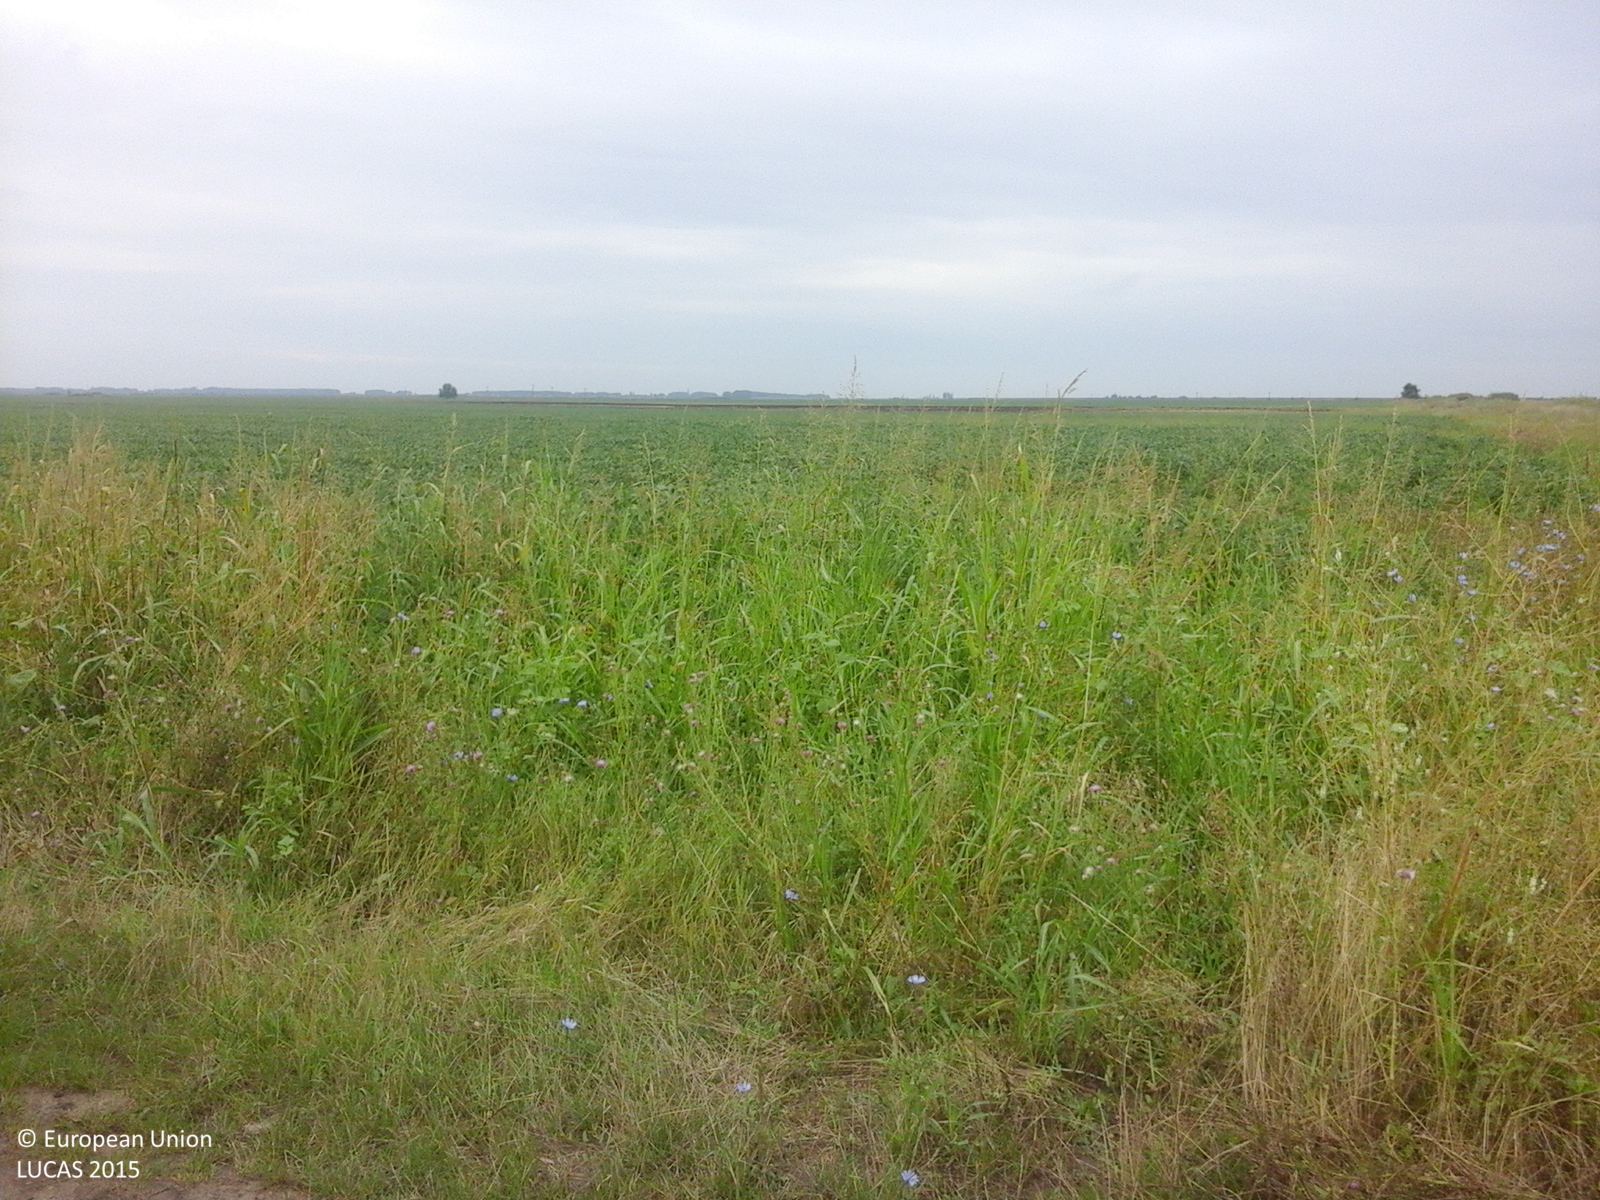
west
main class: Grassland
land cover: Grassland without tree/shrub cover
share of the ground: > 75 %
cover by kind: herbaceous plants 100 %
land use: Agriculture (excluding fallow land and kitchen gardens)
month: August
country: RO
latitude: 45.4413
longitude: 20.9565
